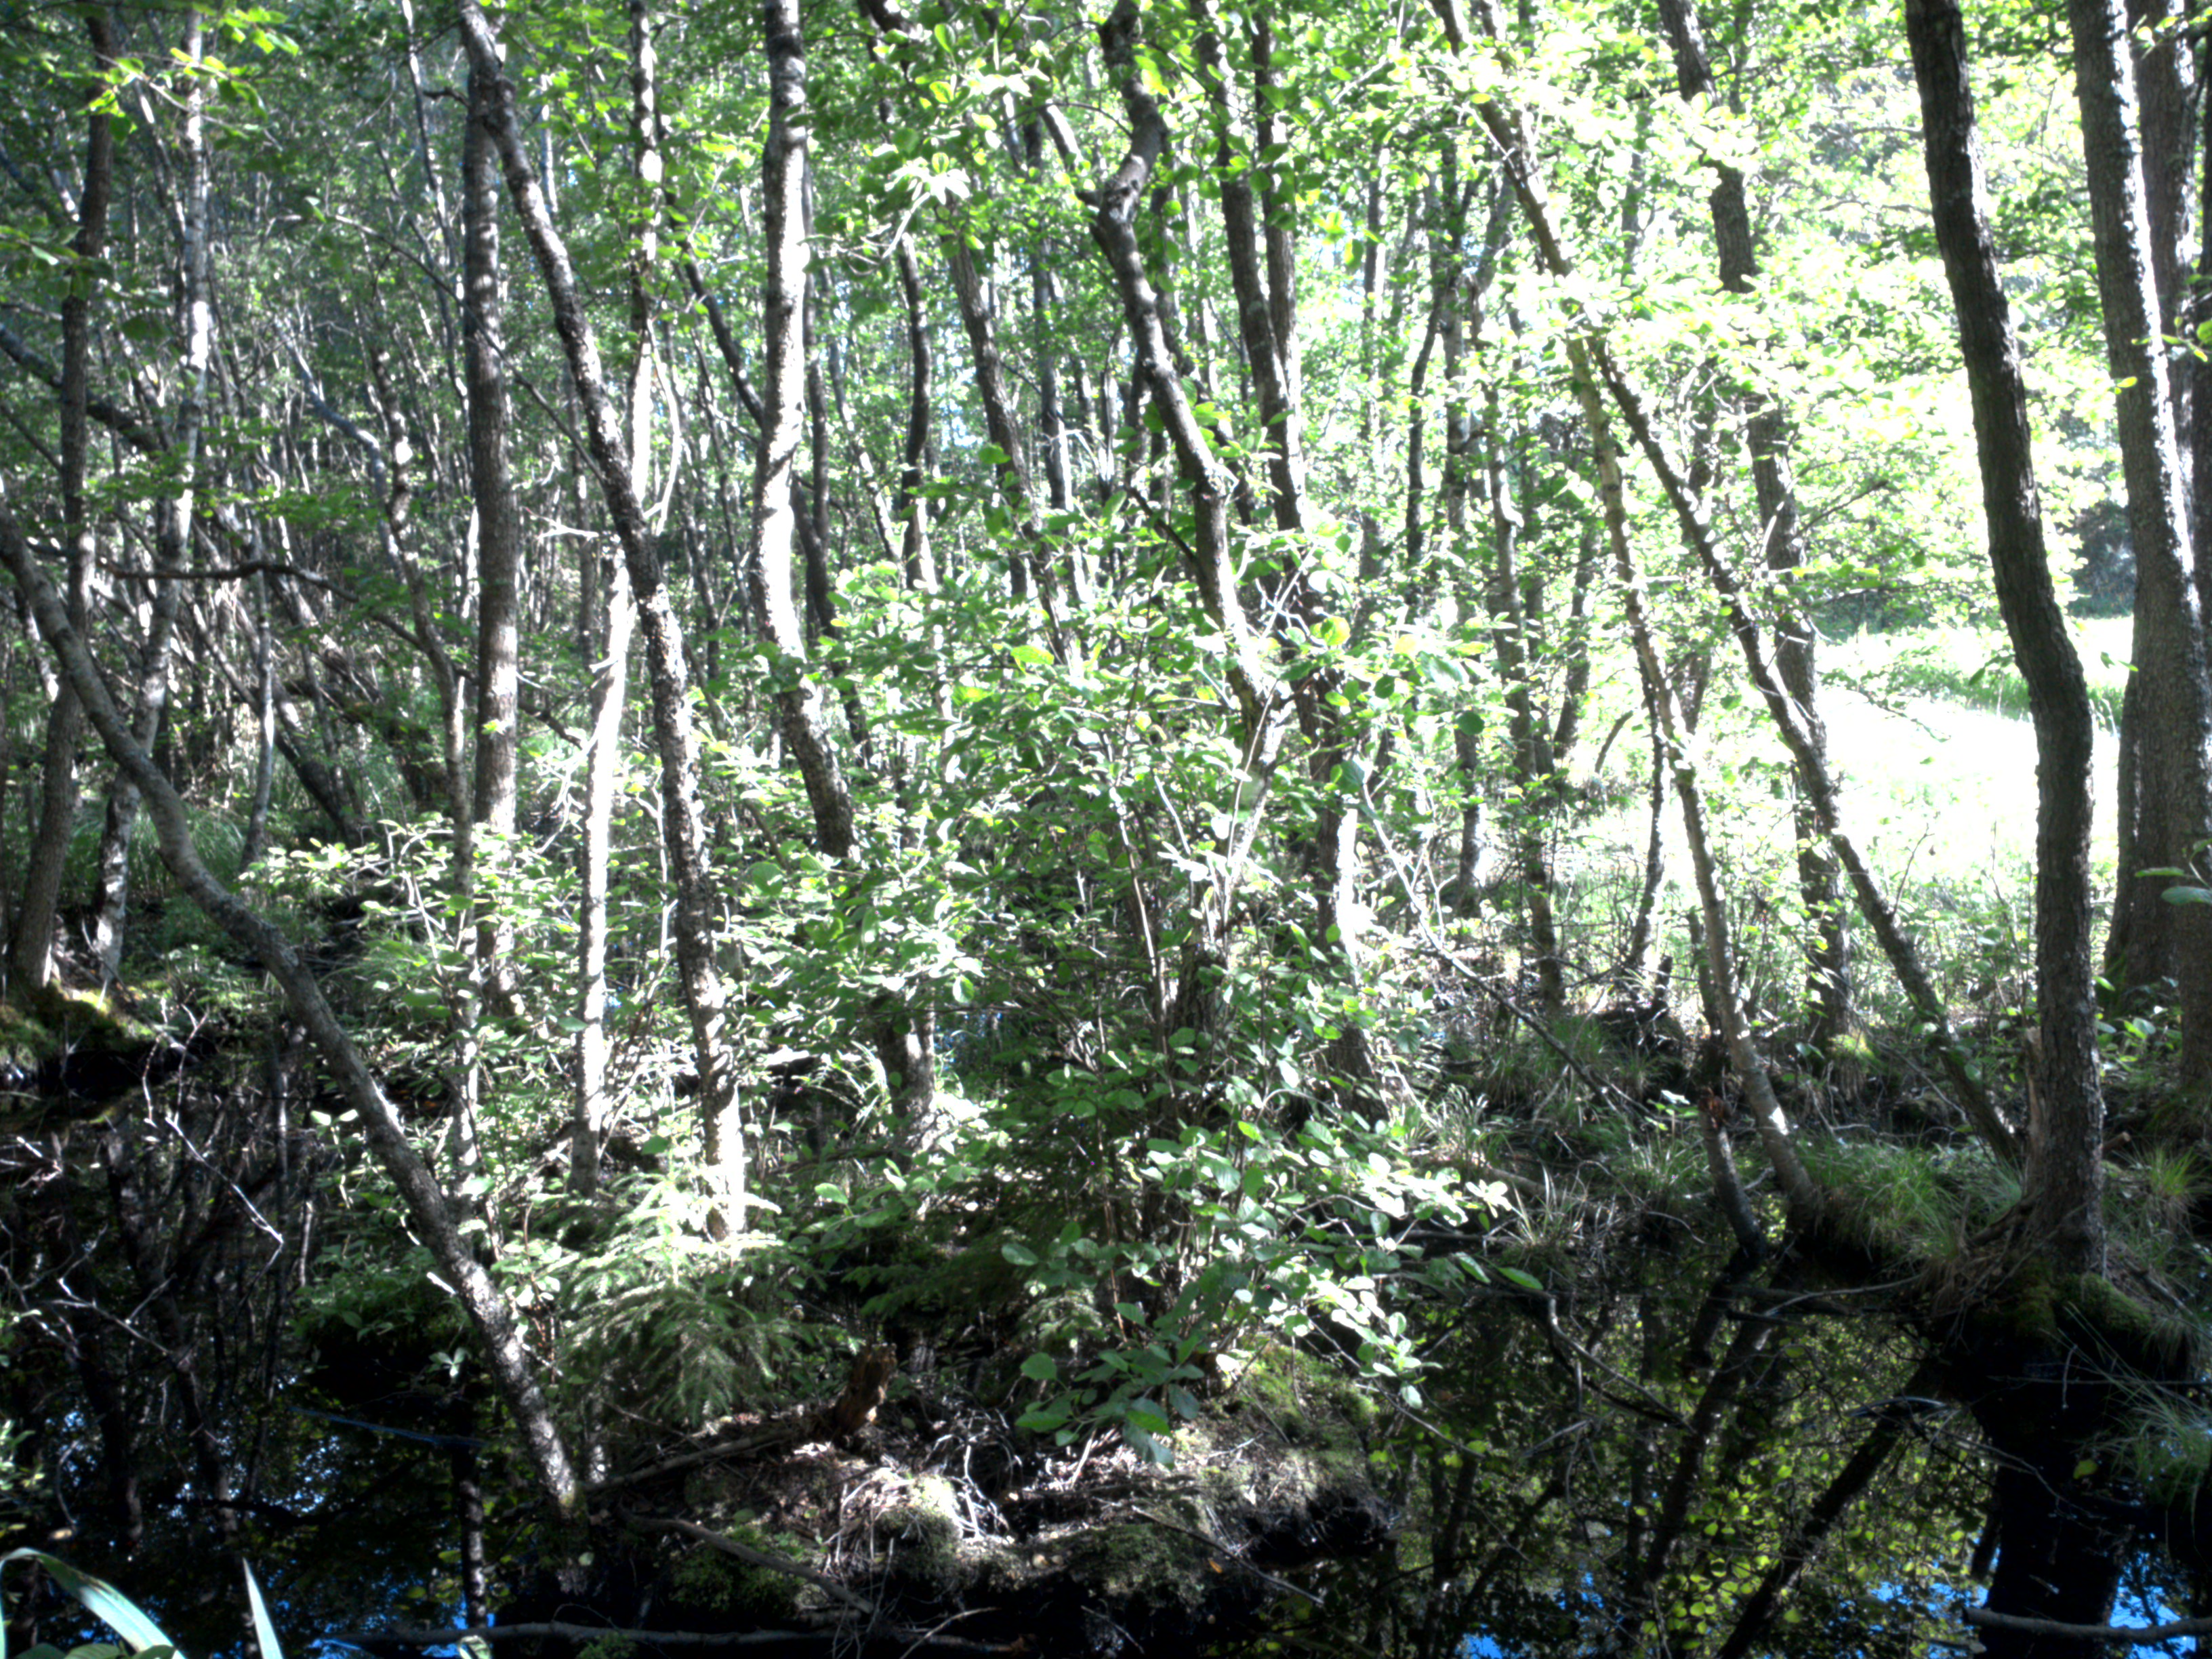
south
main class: Woodland
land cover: Broadleaved woodland
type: mire and swamp forests
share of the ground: > 75 %
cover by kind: broadleaved forest trees 90 %
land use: Semi-natural and natural areas not in use
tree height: > 5 m
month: June
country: SE
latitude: 59.2244
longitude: 17.4431
